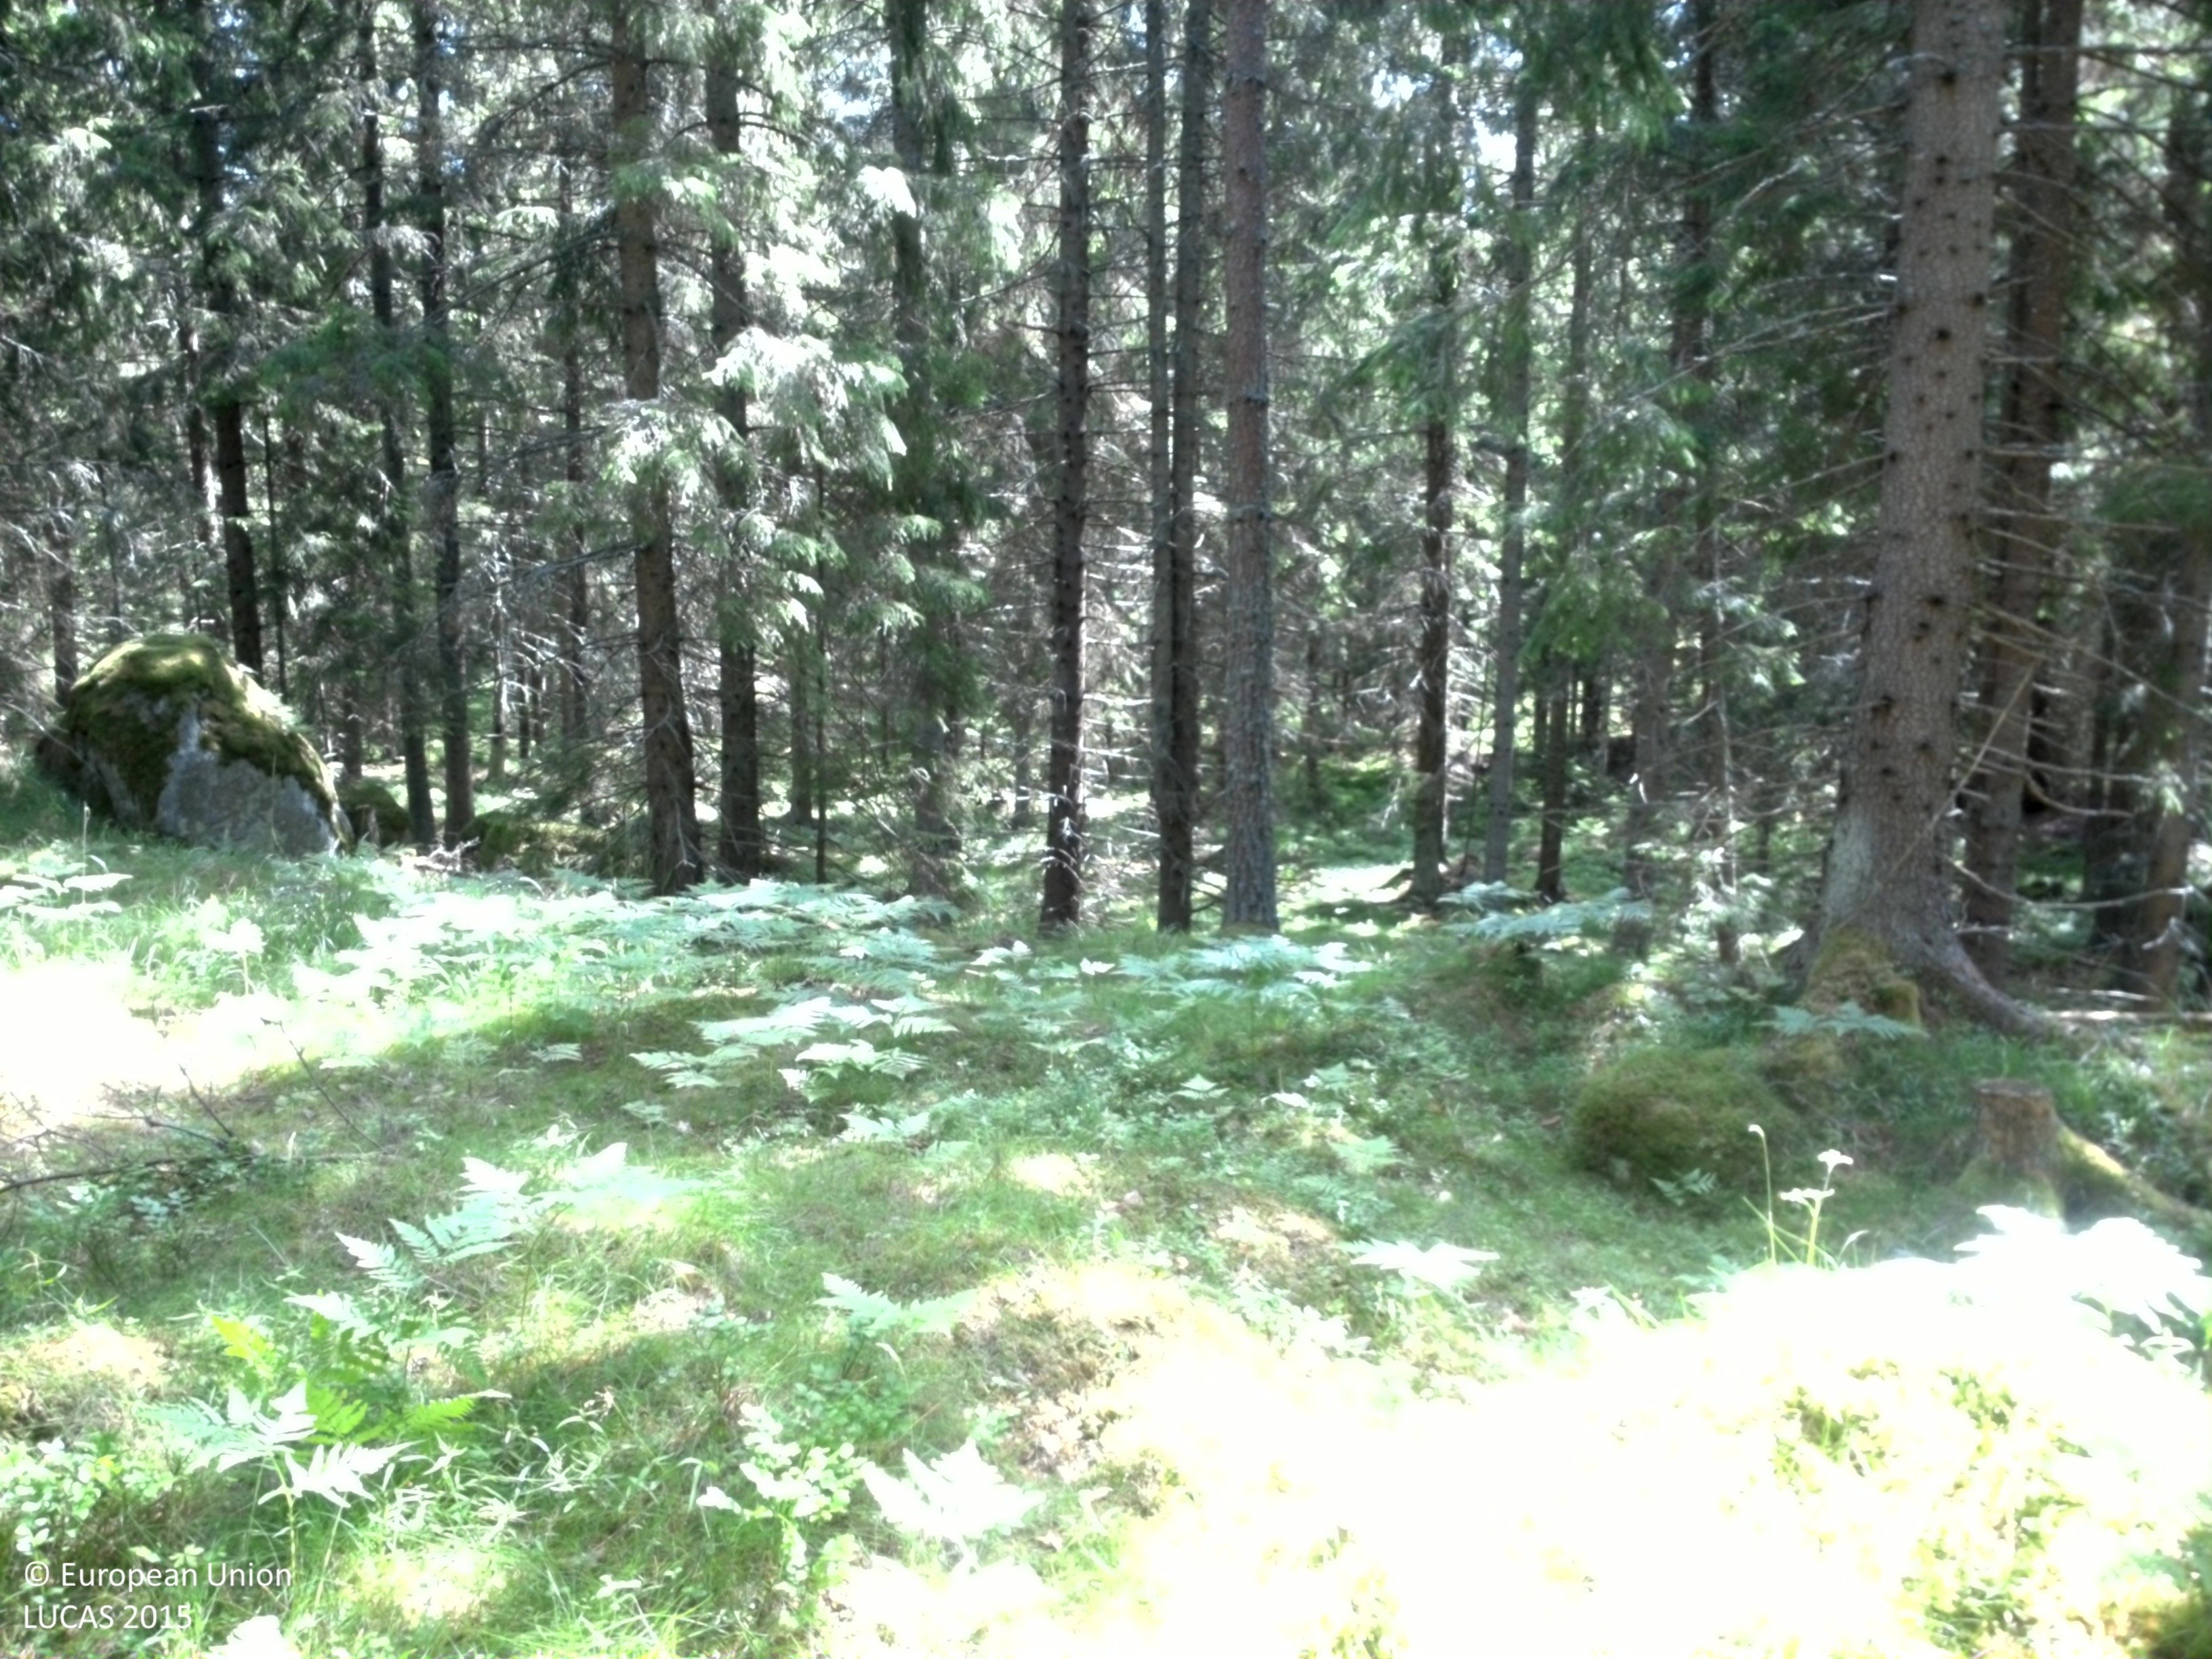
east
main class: Woodland
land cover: Pine dominated coniferous woodland
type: boreal forest
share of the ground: 10 - 25 %
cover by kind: herbaceous plants 60 %, coniferous forest trees 20 %, lichens and mosses 20 %
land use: Community services
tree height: > 5 m
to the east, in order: Pine dominated coniferous woodland; Spruce dominated coniferous woodland; Pine dominated coniferous woodland; Spruce dominated coniferous woodland; Pine dominated coniferous woodland
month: June
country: SE
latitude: 58.5974
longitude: 15.4139
